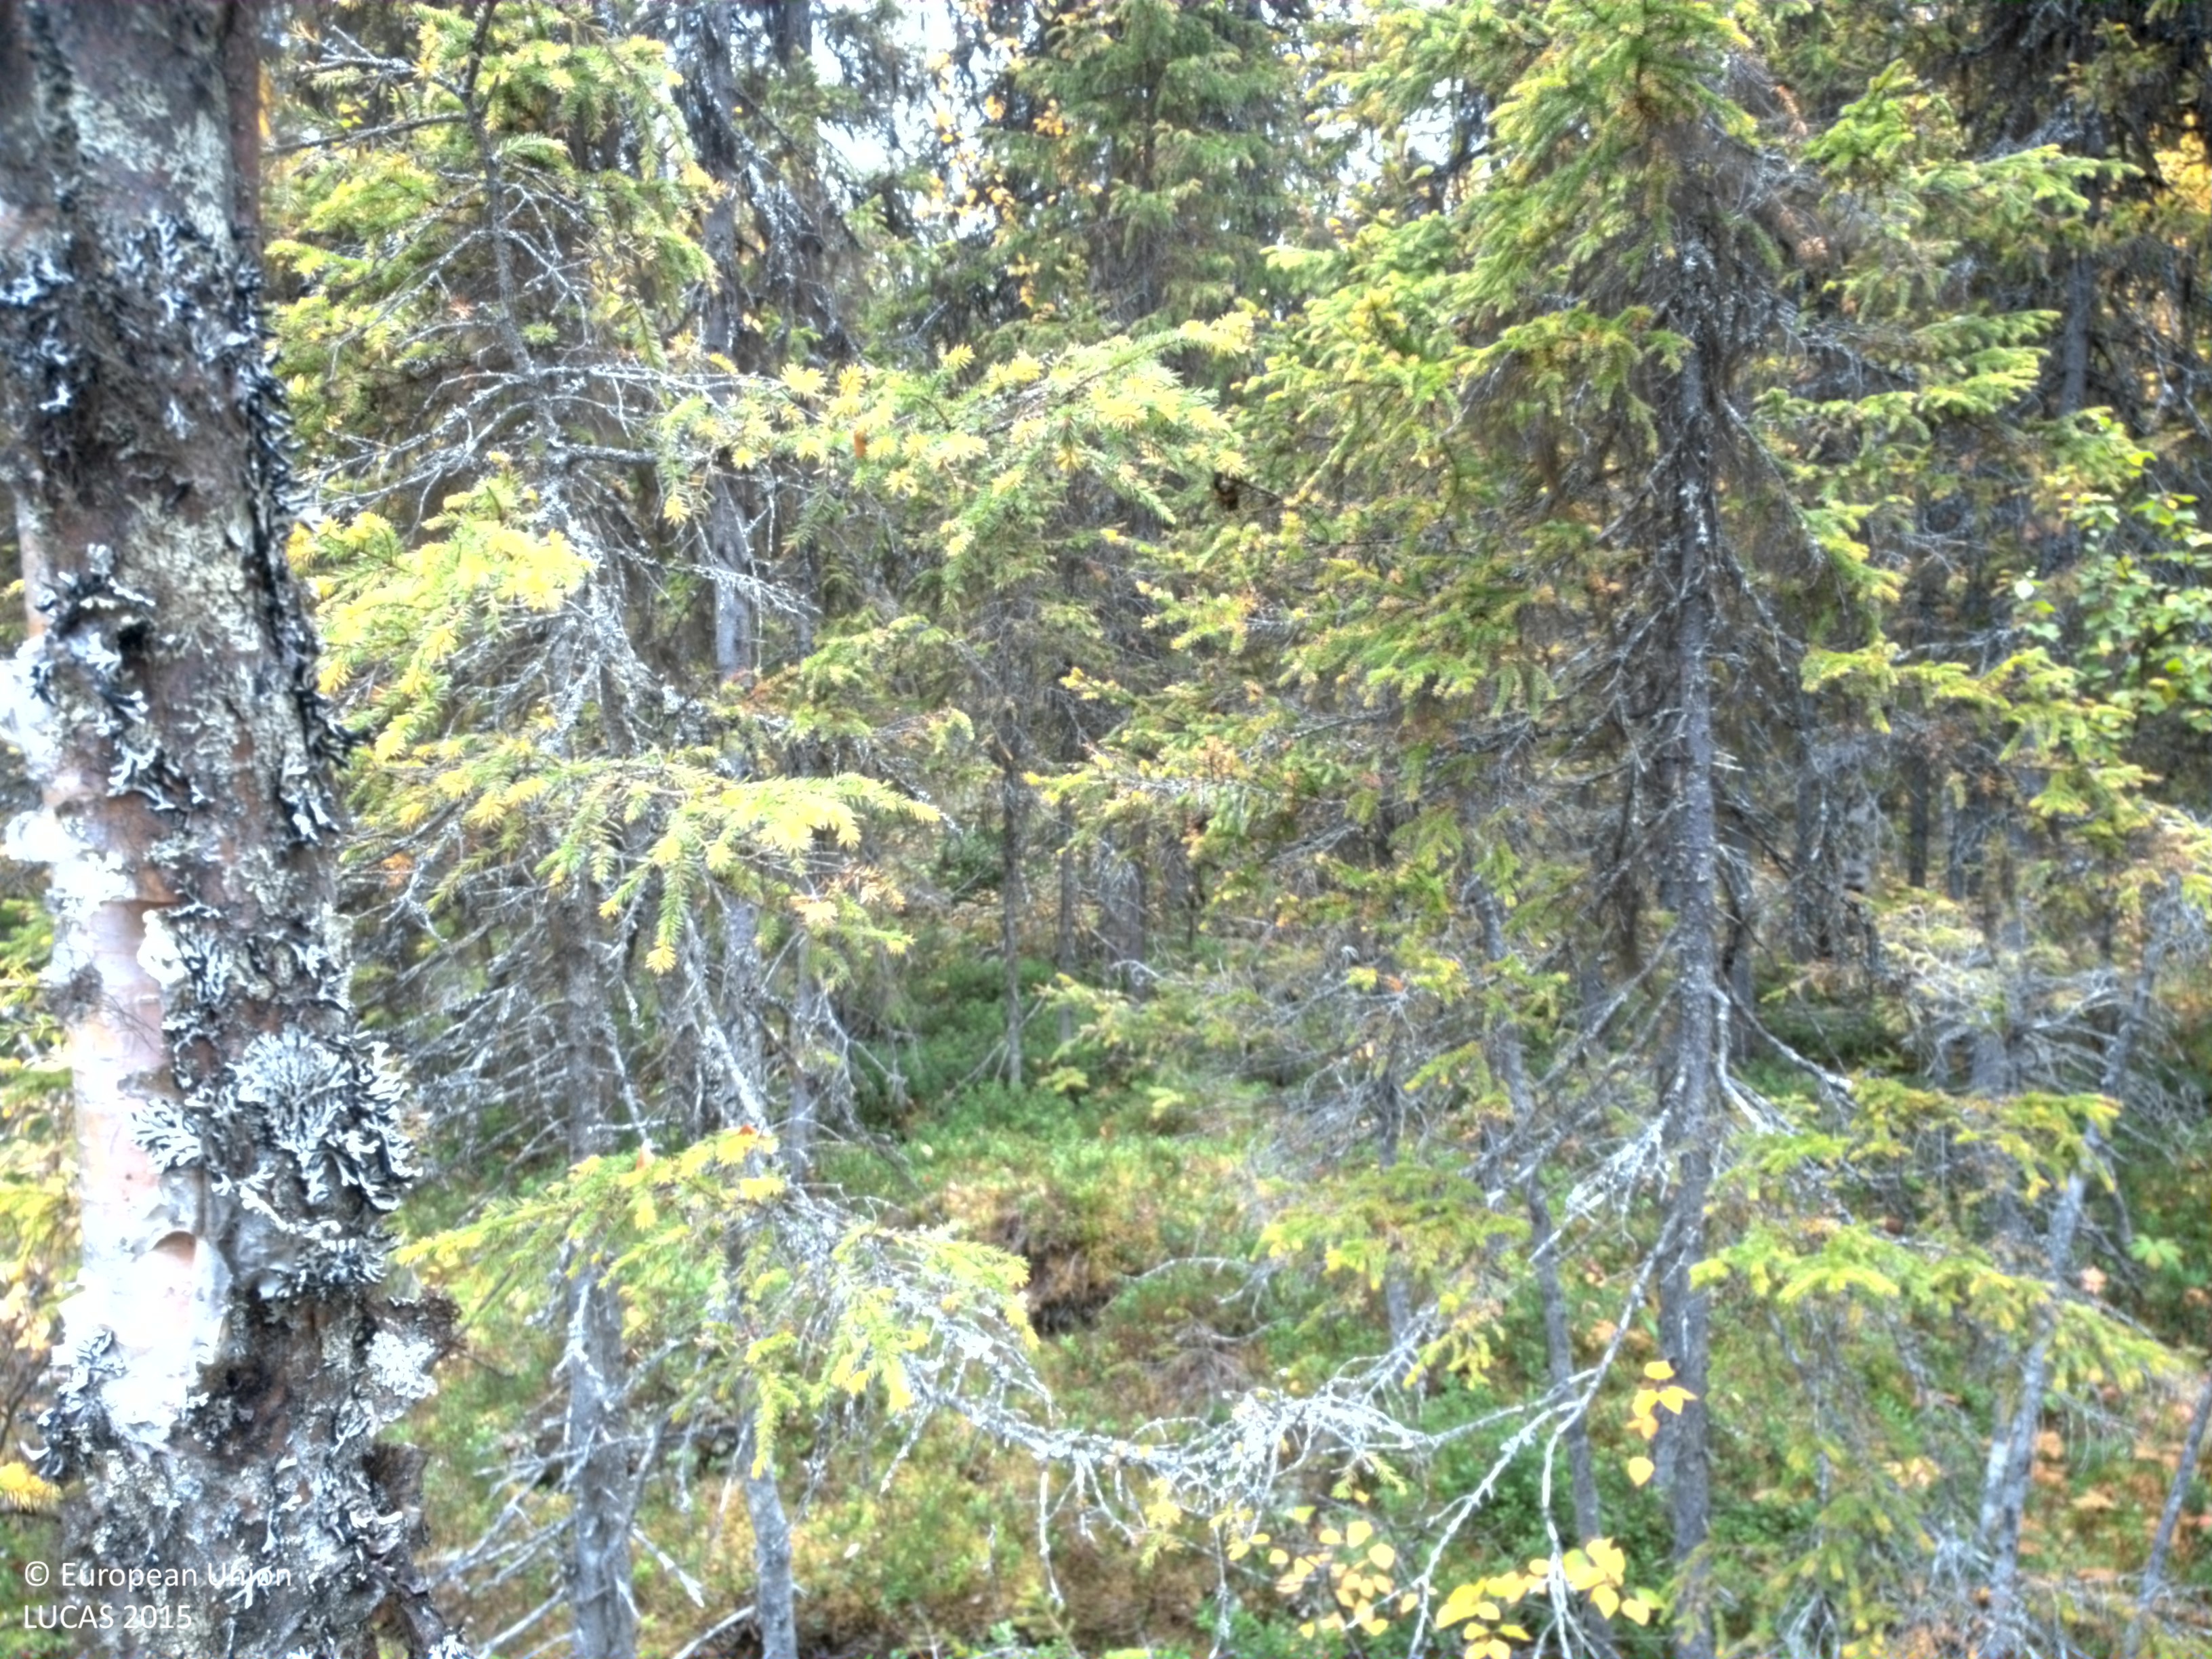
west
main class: Woodland
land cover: Spruce dominated coniferous woodland
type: boreal forest
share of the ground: 25 - 50 %
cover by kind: shrubs 40 %, coniferous forest trees 35 %, lichens and mosses 15 %, broadleaved forest trees 5 %, herbaceous plants 5 %
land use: Forestry
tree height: > 5 m
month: September
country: SE
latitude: 65.1176
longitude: 16.9284
